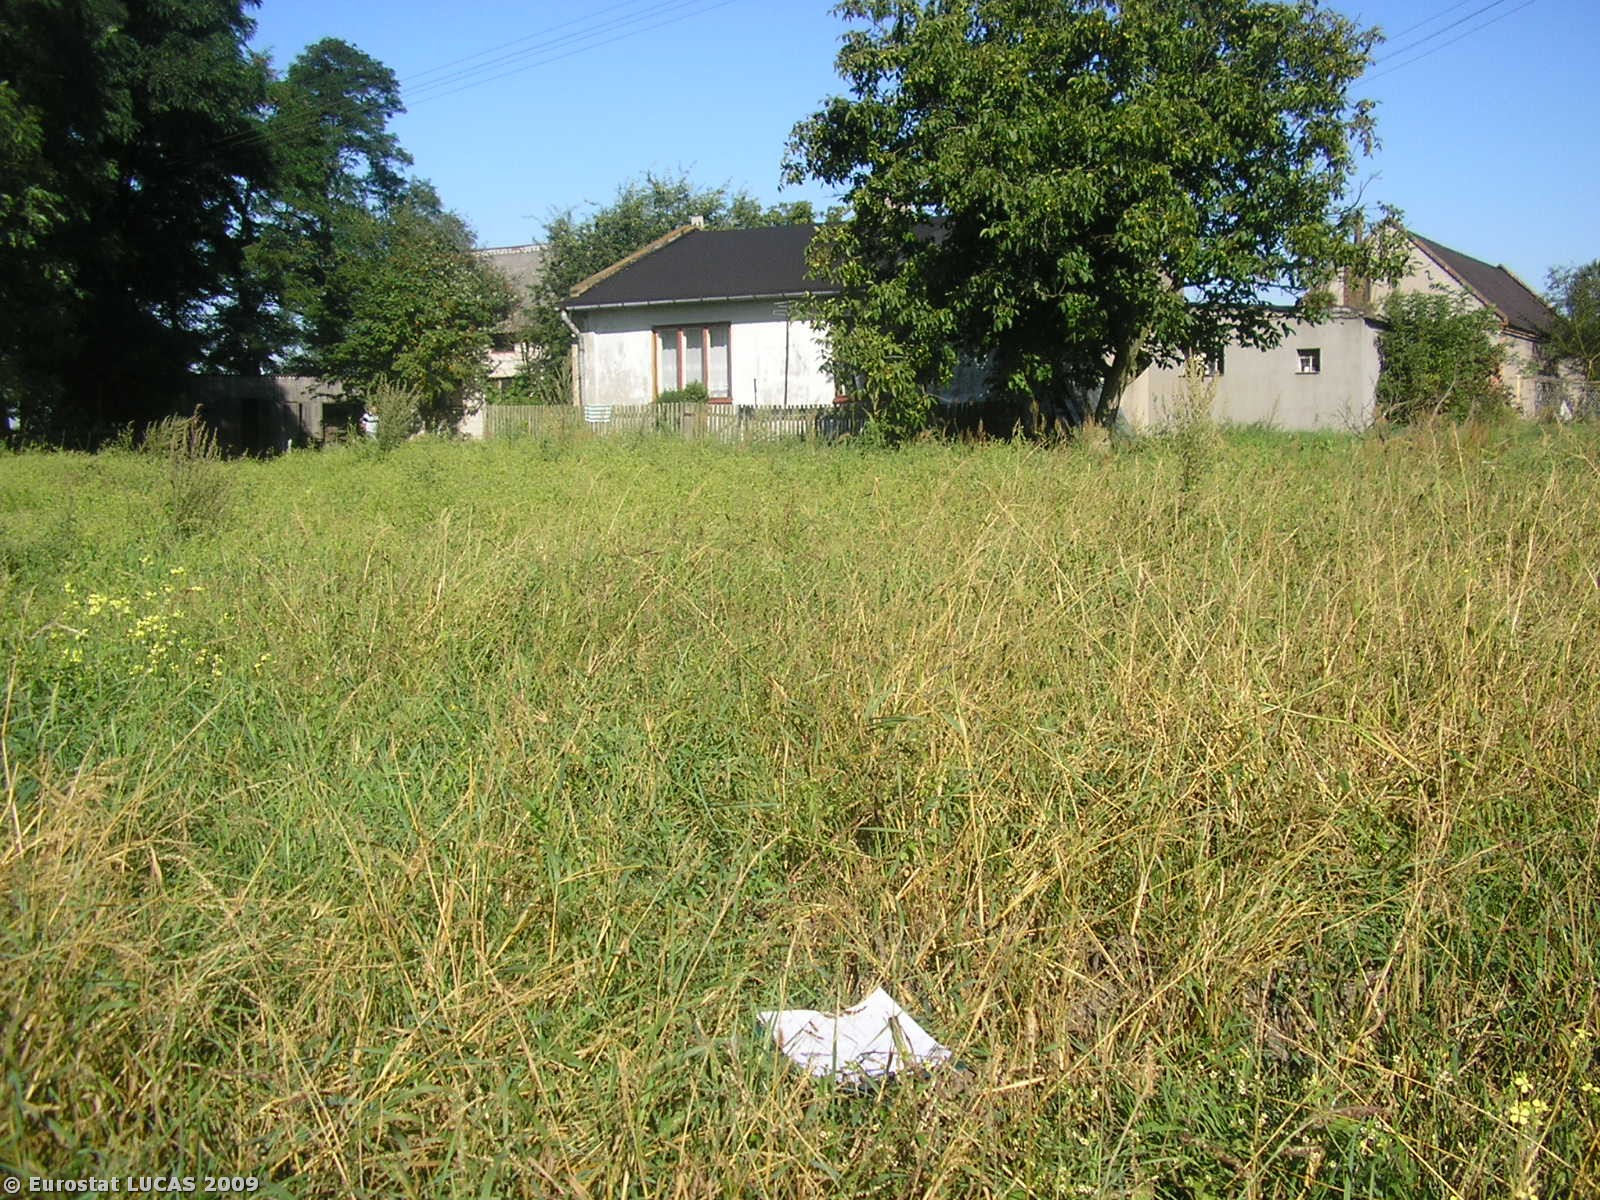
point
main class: Cropland
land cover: Potatoes
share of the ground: 25 - 50 %
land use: Agriculture (excluding fallow land and kitchen gardens)
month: September
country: PL
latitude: 51.9617
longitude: 19.4727
